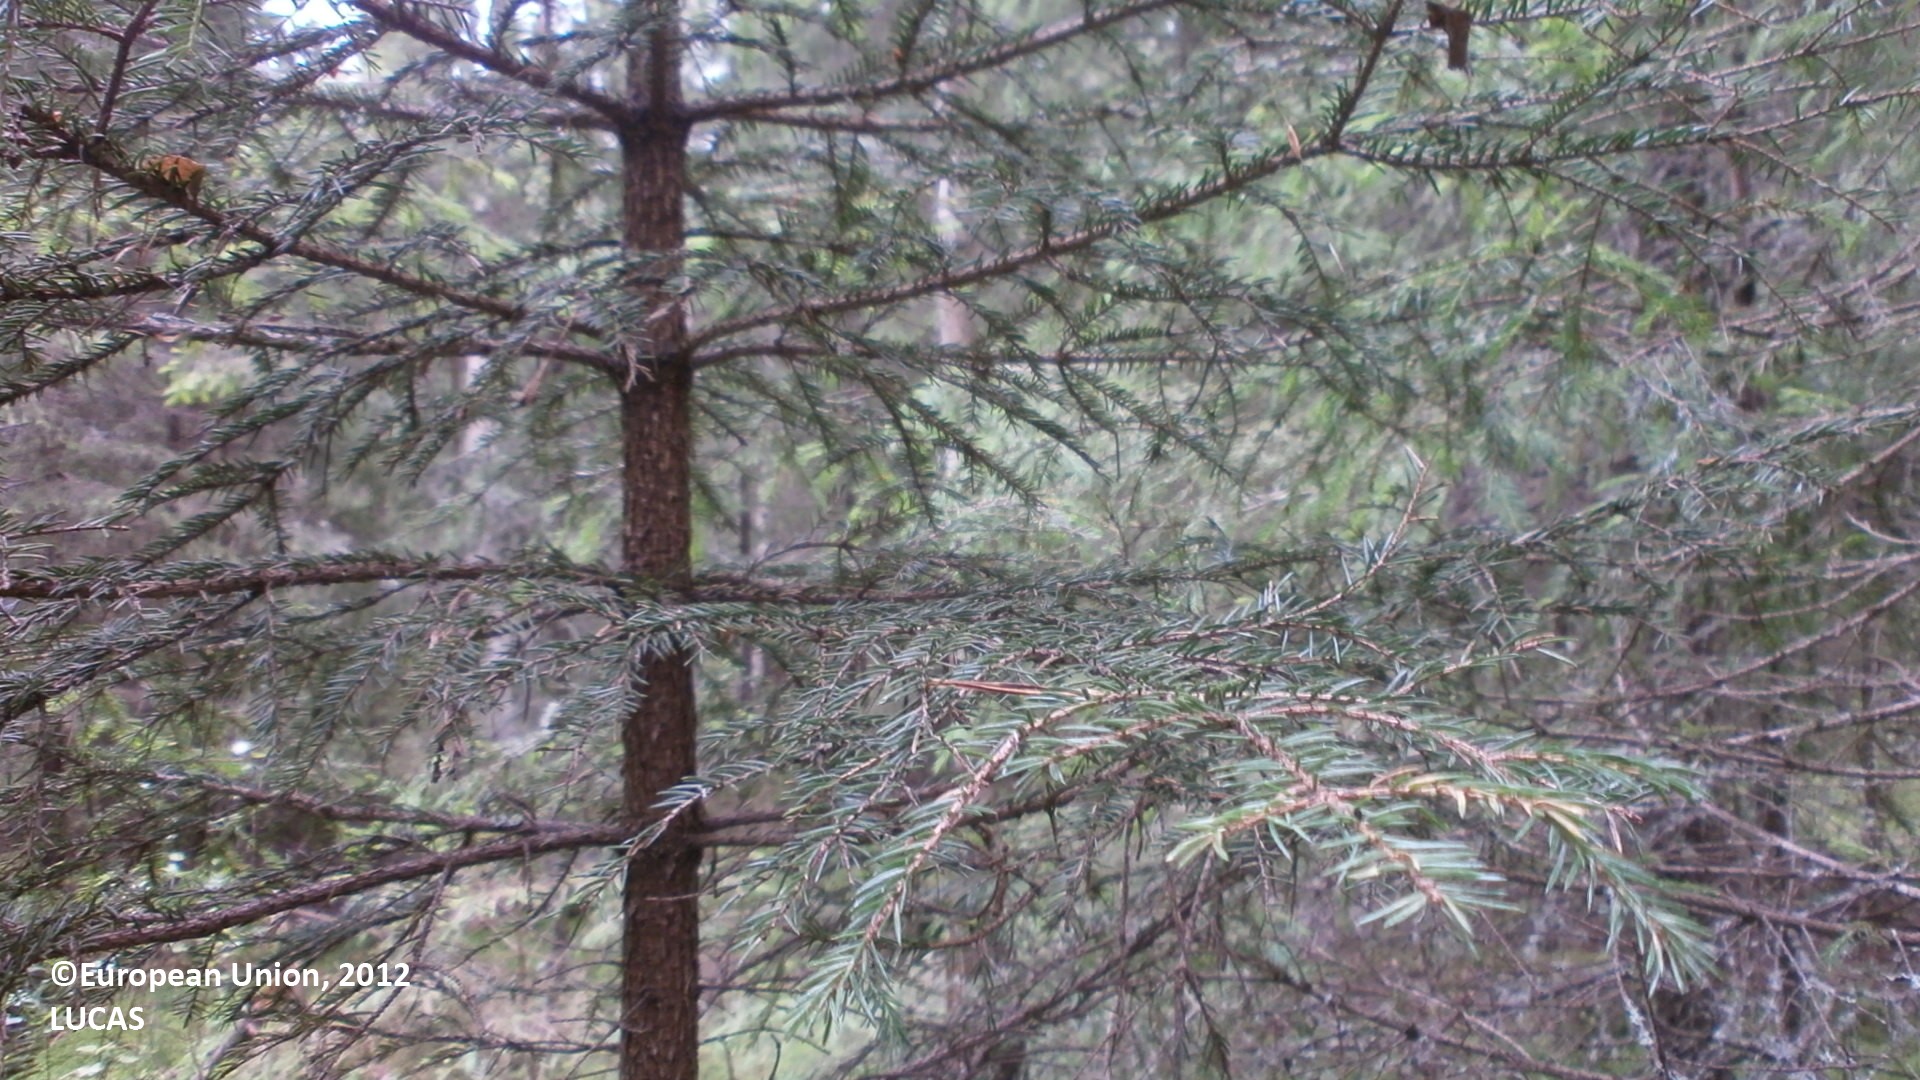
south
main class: Woodland
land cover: Spruce dominated mixed woodland
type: boreal forest
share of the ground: > 75 %
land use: Forestry
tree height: > 5 m
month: July
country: FI
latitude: 64.2137
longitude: 24.2215
